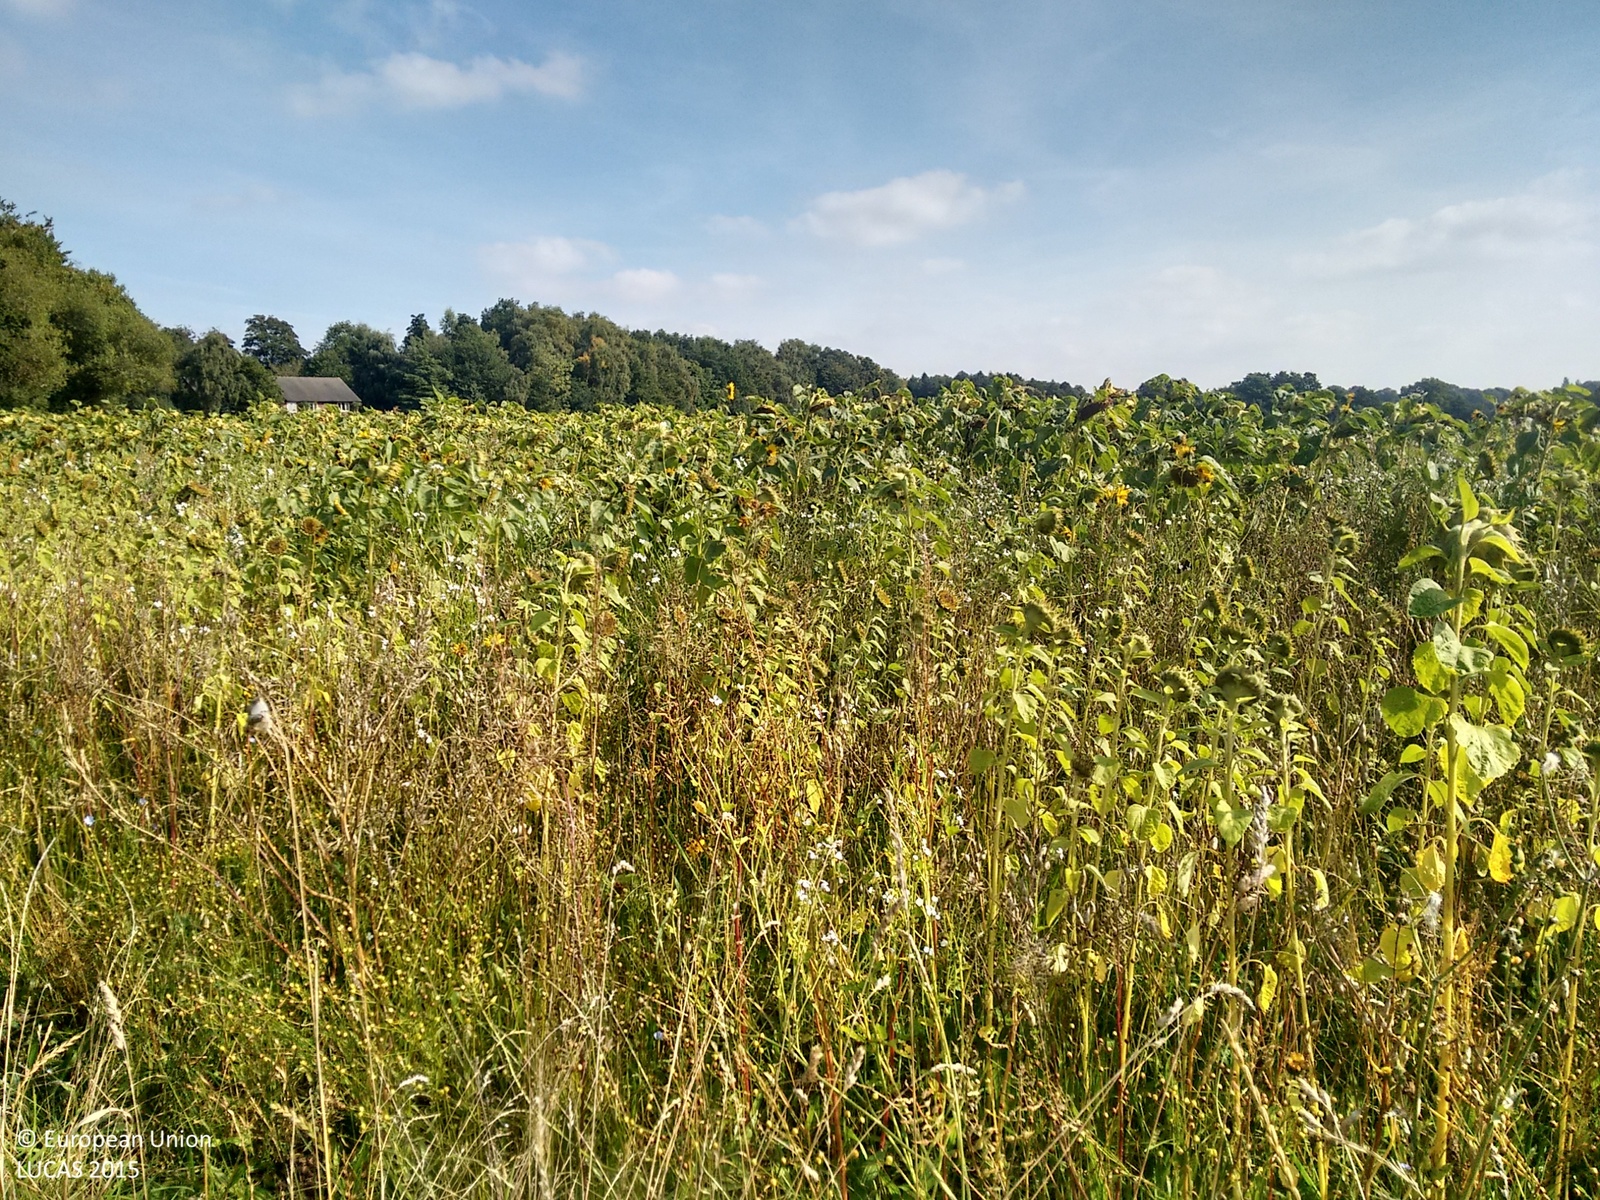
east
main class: Grassland
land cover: Grassland without tree/shrub cover
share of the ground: > 75 %
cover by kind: herbaceous plants 100 %
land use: Agriculture (excluding fallow land and kitchen gardens)
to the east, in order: Grassland without tree/shrub cover; Sunflower; Grassland without tree/shrub cover; Broadleaved woodland; Tracks
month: September
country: GB
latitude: 52.8081
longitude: -2.3016
